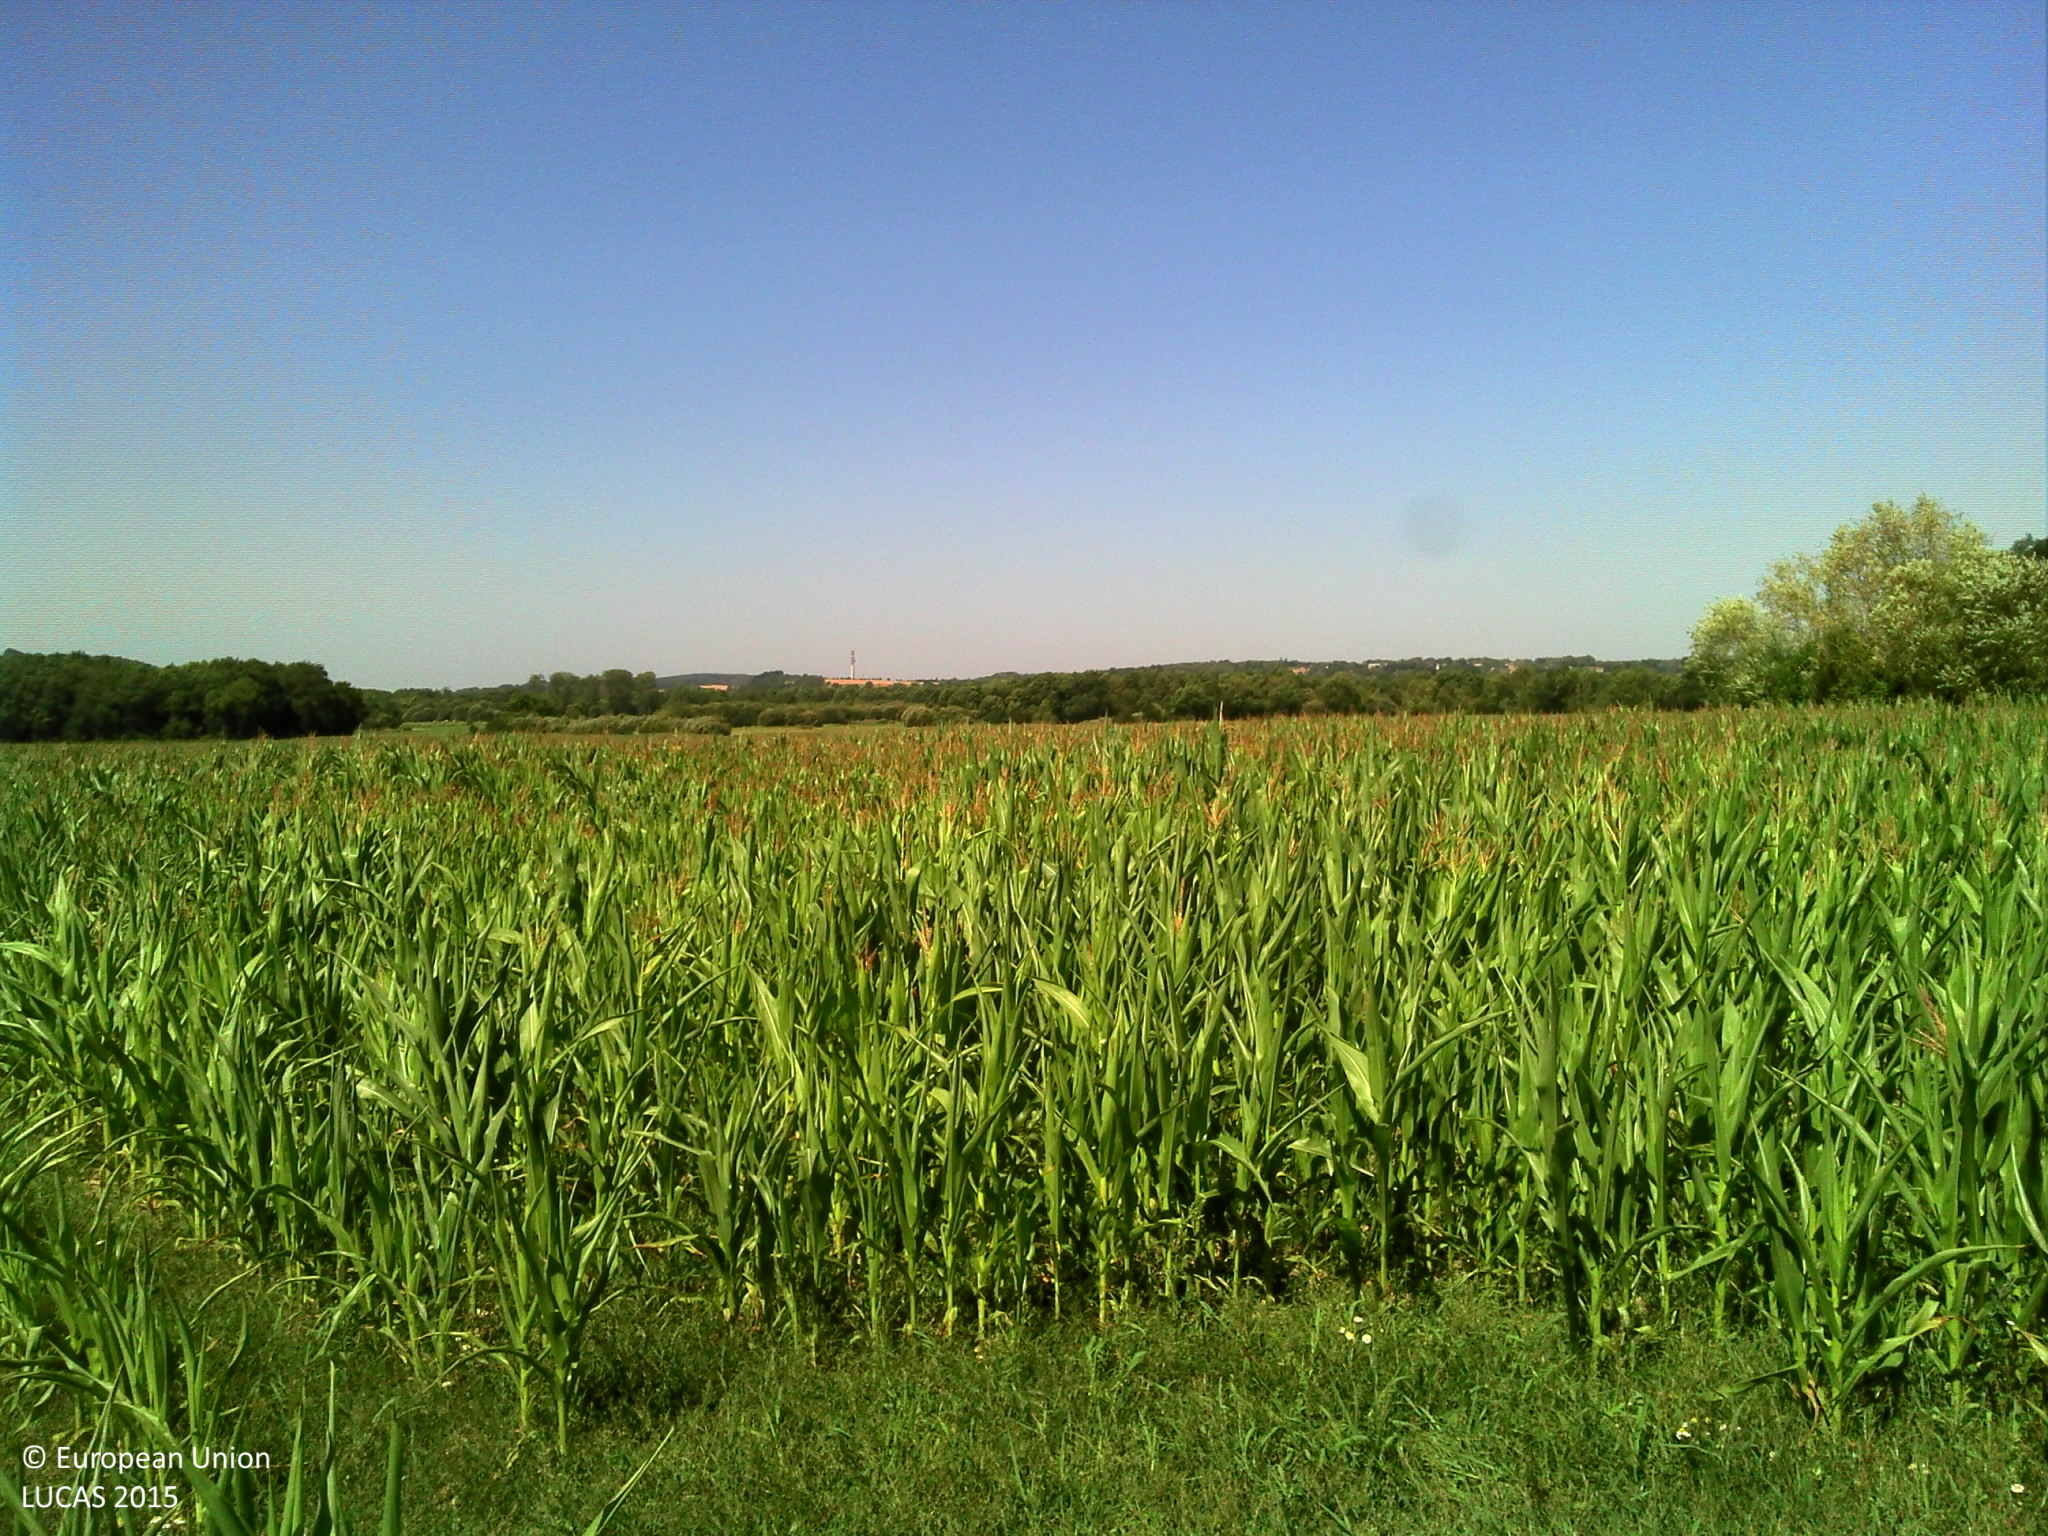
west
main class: Cropland
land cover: Maize
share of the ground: 50 - 75 %
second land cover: Spontaneously vegetated surfaces
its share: 10 - 25 %
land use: Agriculture (excluding fallow land and kitchen gardens)
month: July
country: FR
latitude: 47.7127
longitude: -1.8176
